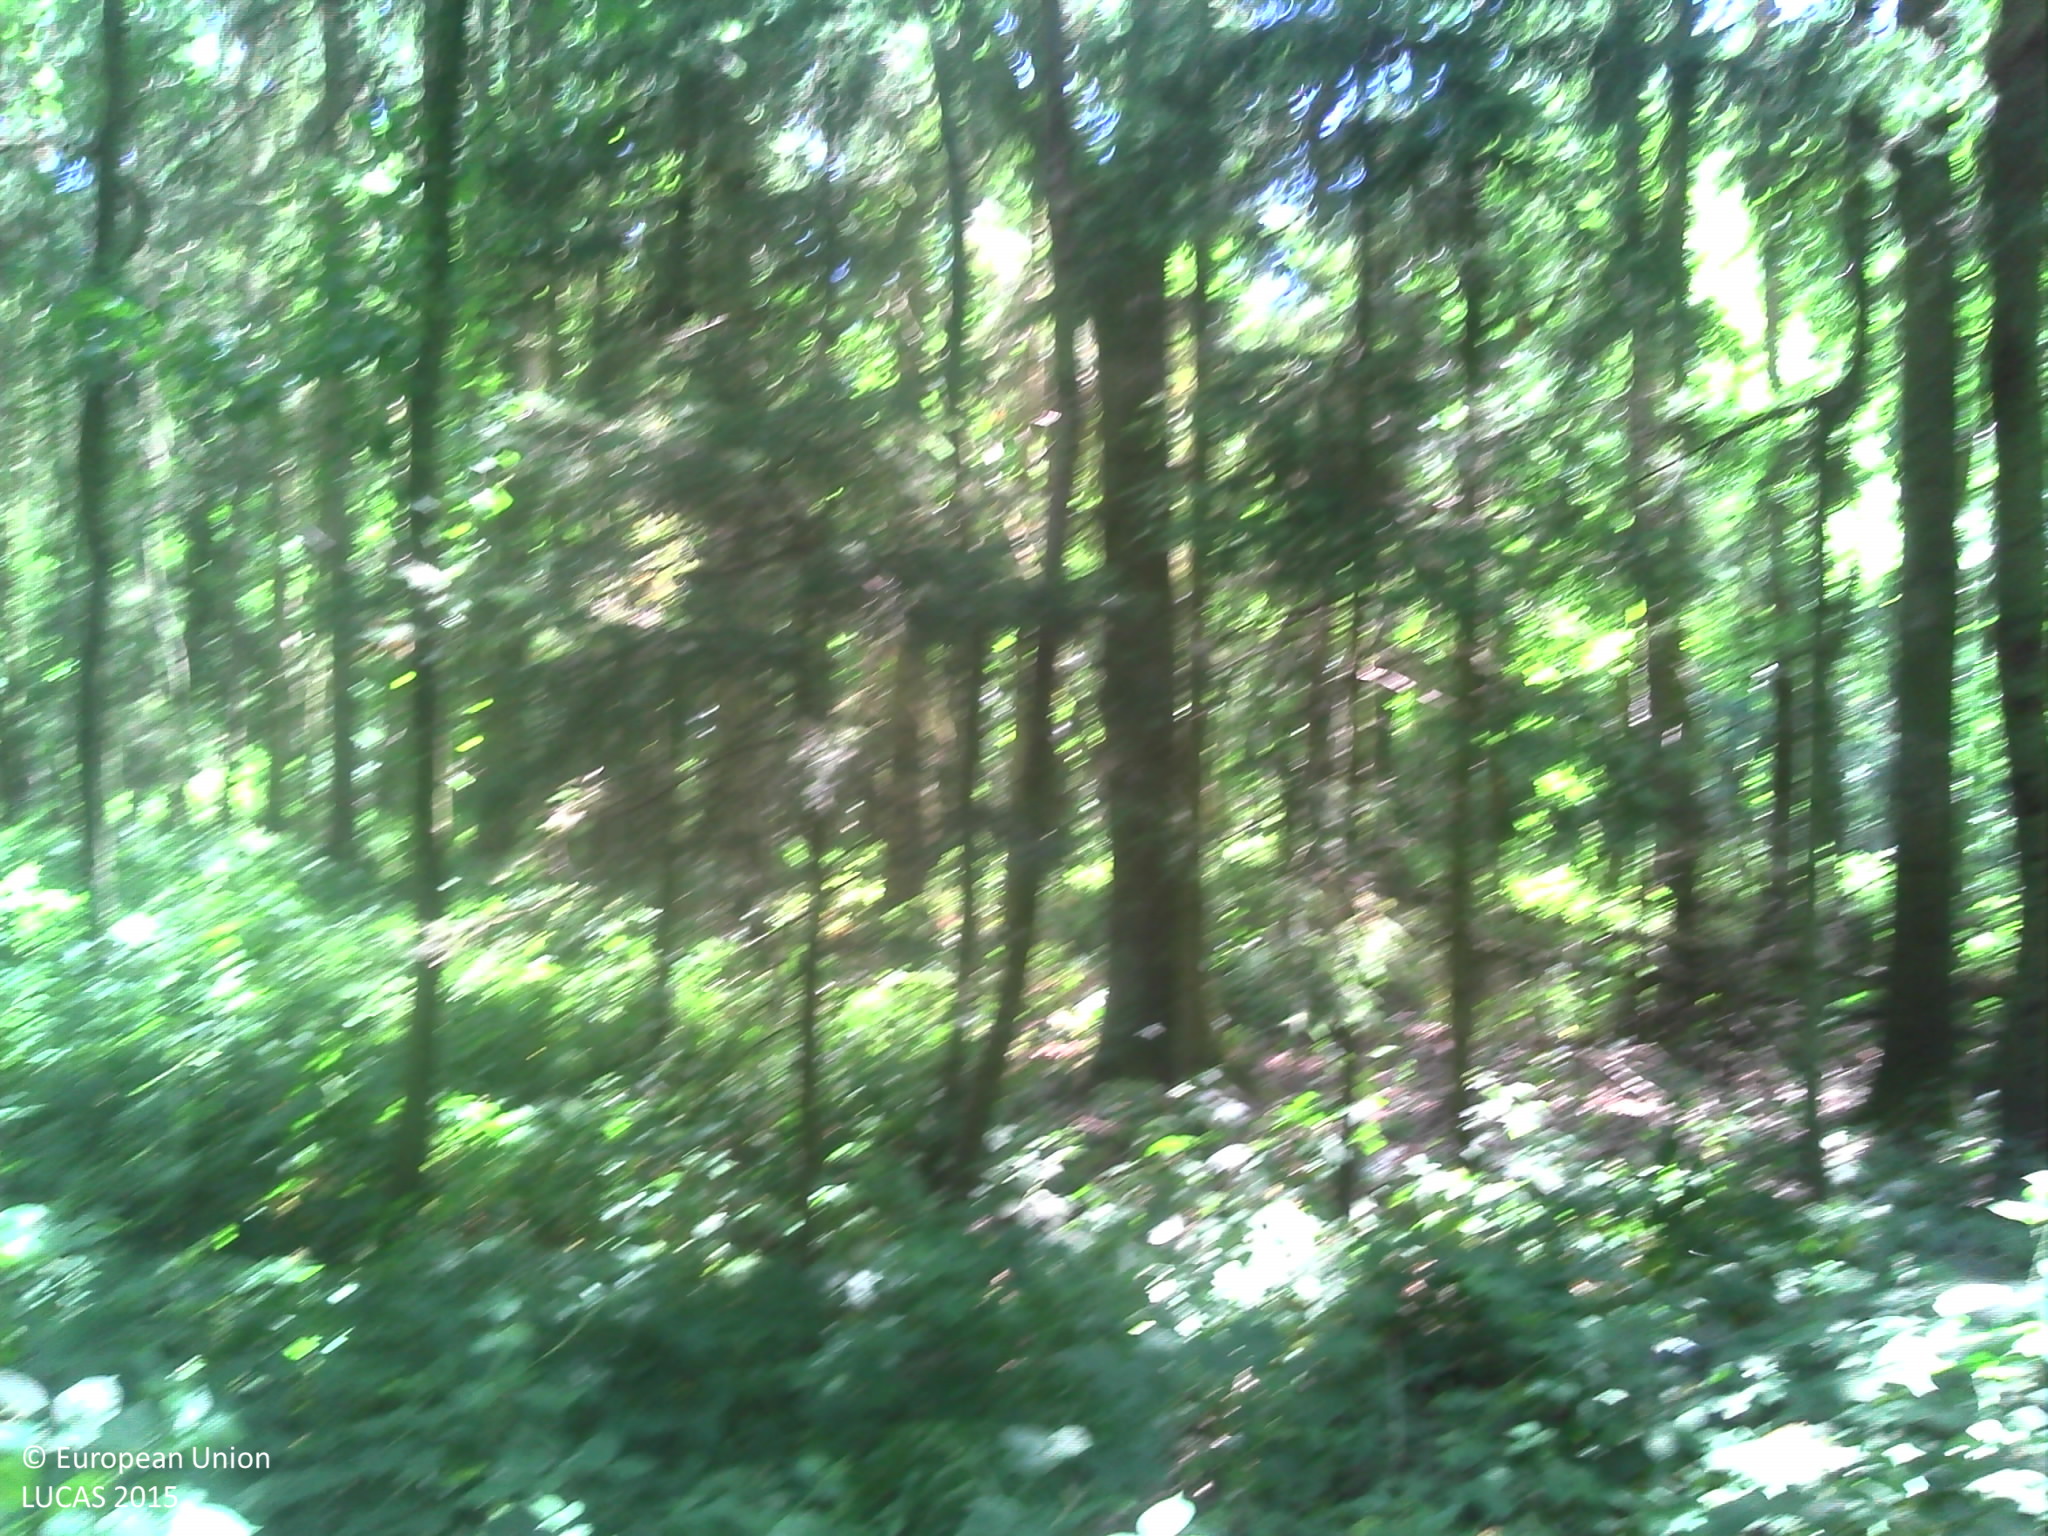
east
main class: Woodland
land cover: Broadleaved woodland
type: acidophilous oak and oak-birch forest
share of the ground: > 75 %
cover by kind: broadleaved forest trees 85 %, shrubs 10 %, coniferous forest trees 5 %
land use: Forestry
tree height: > 5 m
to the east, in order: Broadleaved woodland; Spruce dominated coniferous woodland; Broadleaved woodland
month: July
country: BE
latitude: 50.8166
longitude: 4.6736
